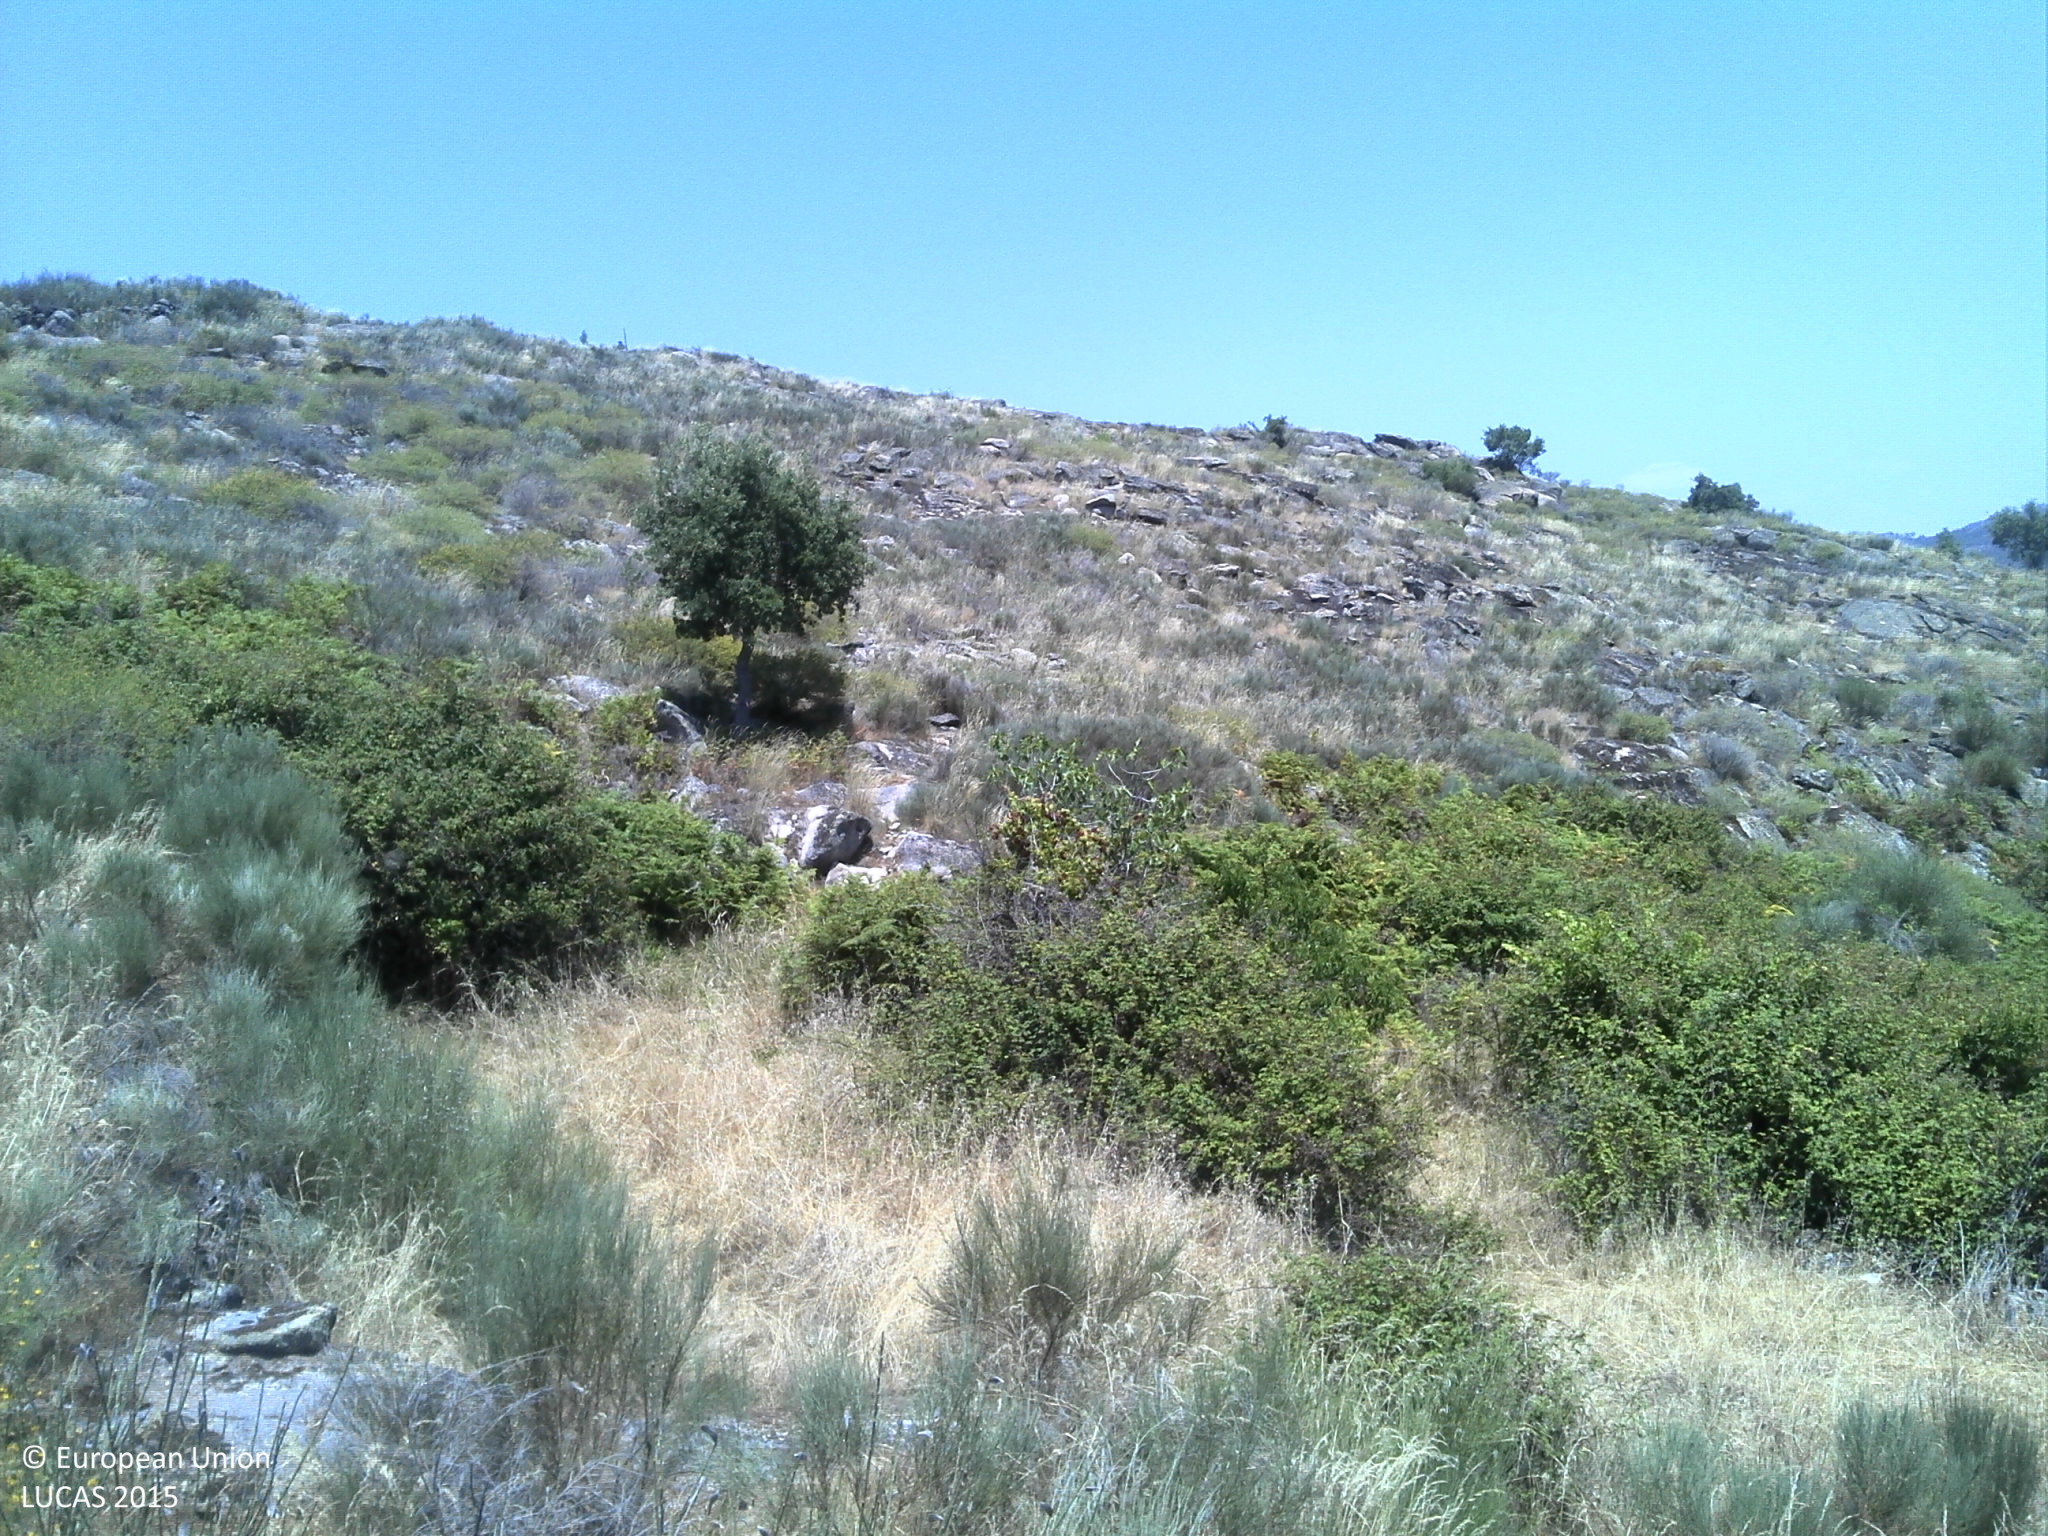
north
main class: Shrubland
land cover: Shrubland with sparse tree cover
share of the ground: 50 - 75 %
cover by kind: shrubs 60 %, herbaceous plants 25 %, broadleaved forest trees 5 %, unconsolidated bare surface 5 %
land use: Forestry
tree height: > 5 m
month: June
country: PT
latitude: 40.0620
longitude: -7.1053
